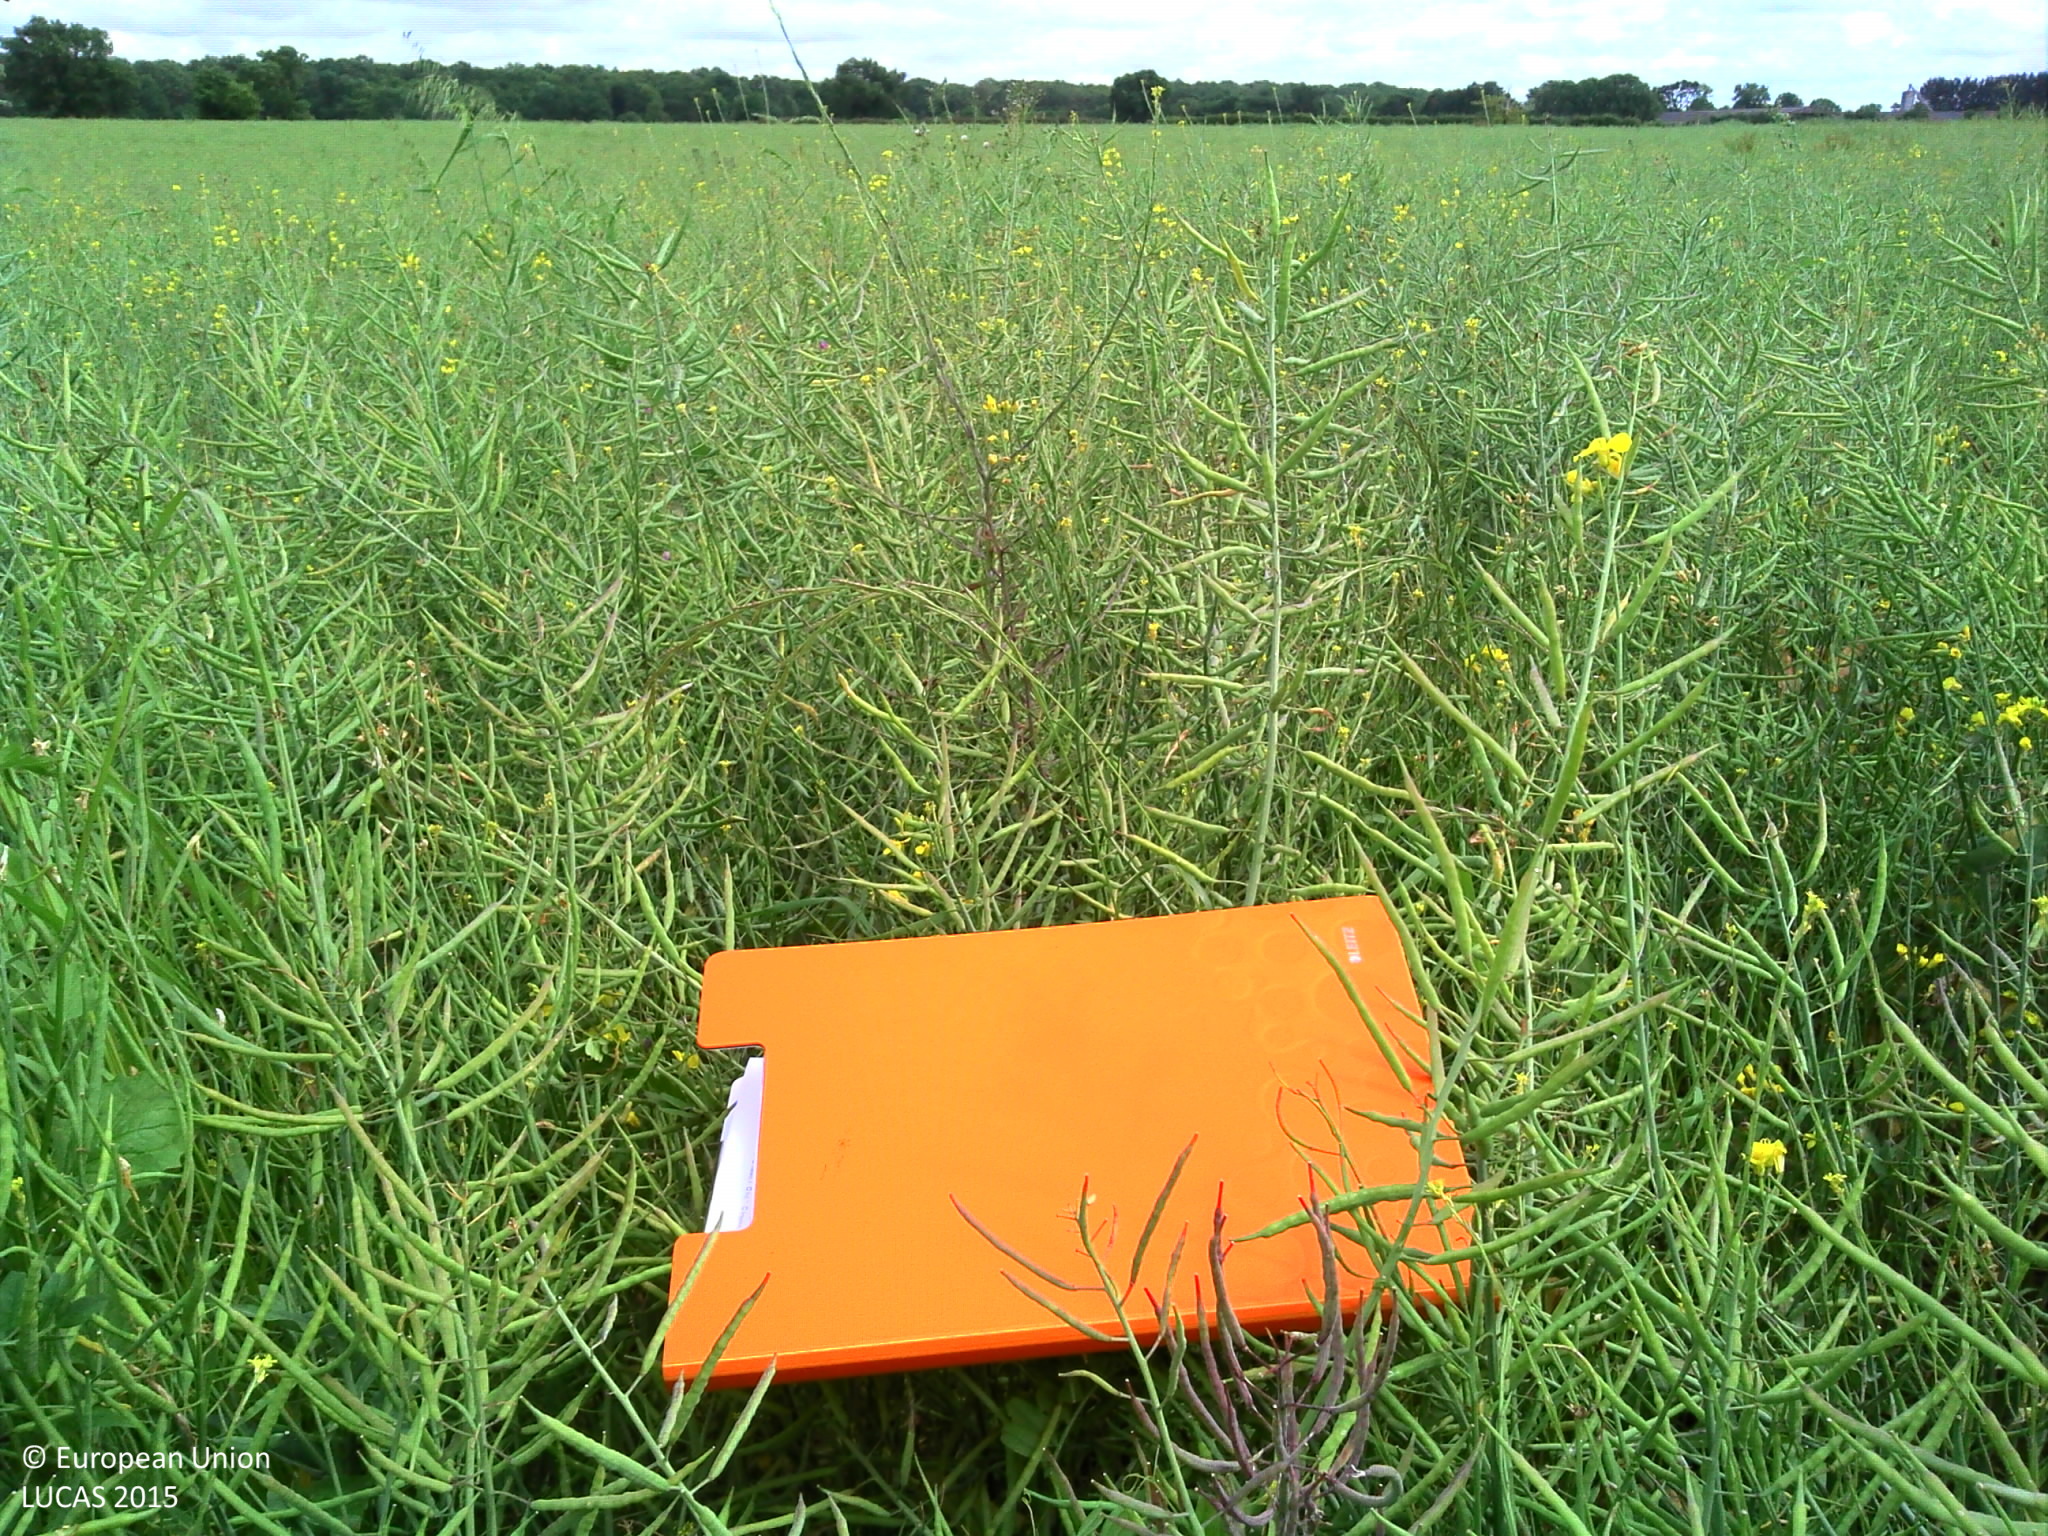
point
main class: Cropland
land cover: Rape and turnip rape
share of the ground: > 75 %
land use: Agriculture (excluding fallow land and kitchen gardens)
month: May
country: FR
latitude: 47.1301
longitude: 2.9421
